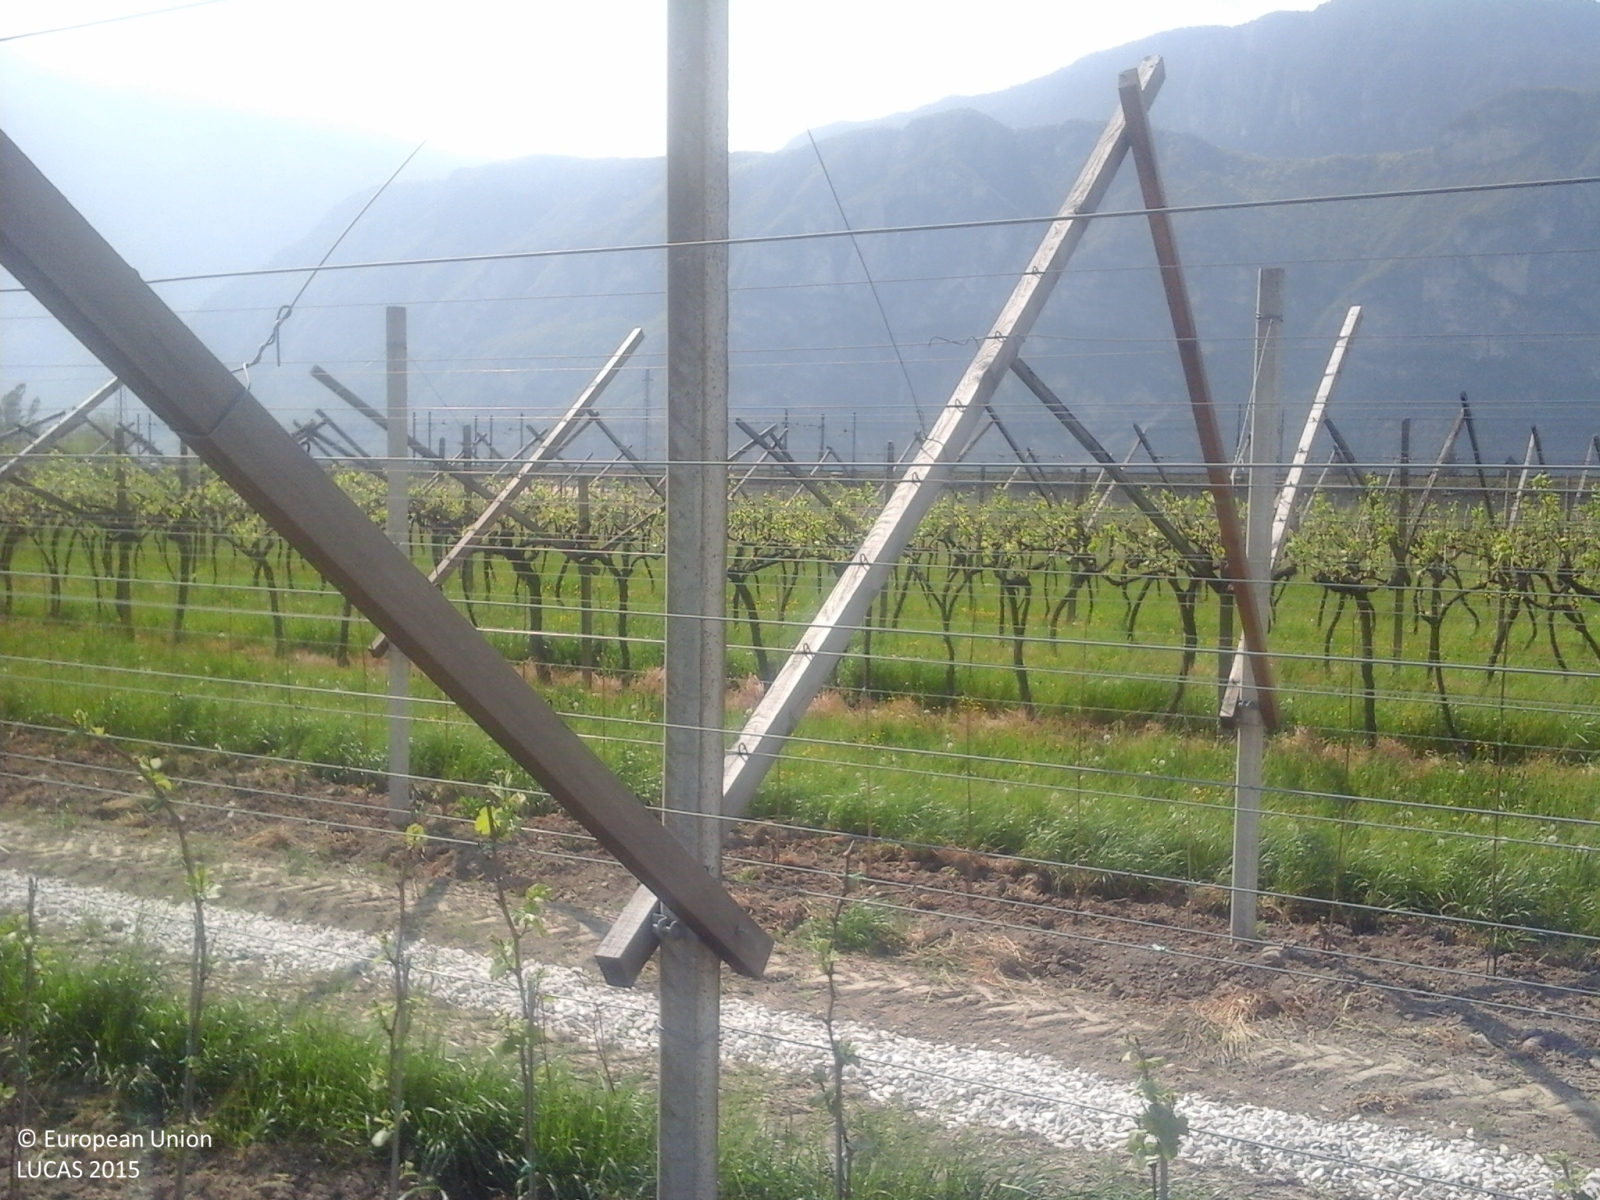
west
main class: Cropland
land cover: Vineyards
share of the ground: < 10 %
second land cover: Grassland without tree/shrub cover
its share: 25 - 50 %
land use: Agriculture (excluding fallow land and kitchen gardens)
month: April
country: IT
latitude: 46.1831
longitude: 11.1256
